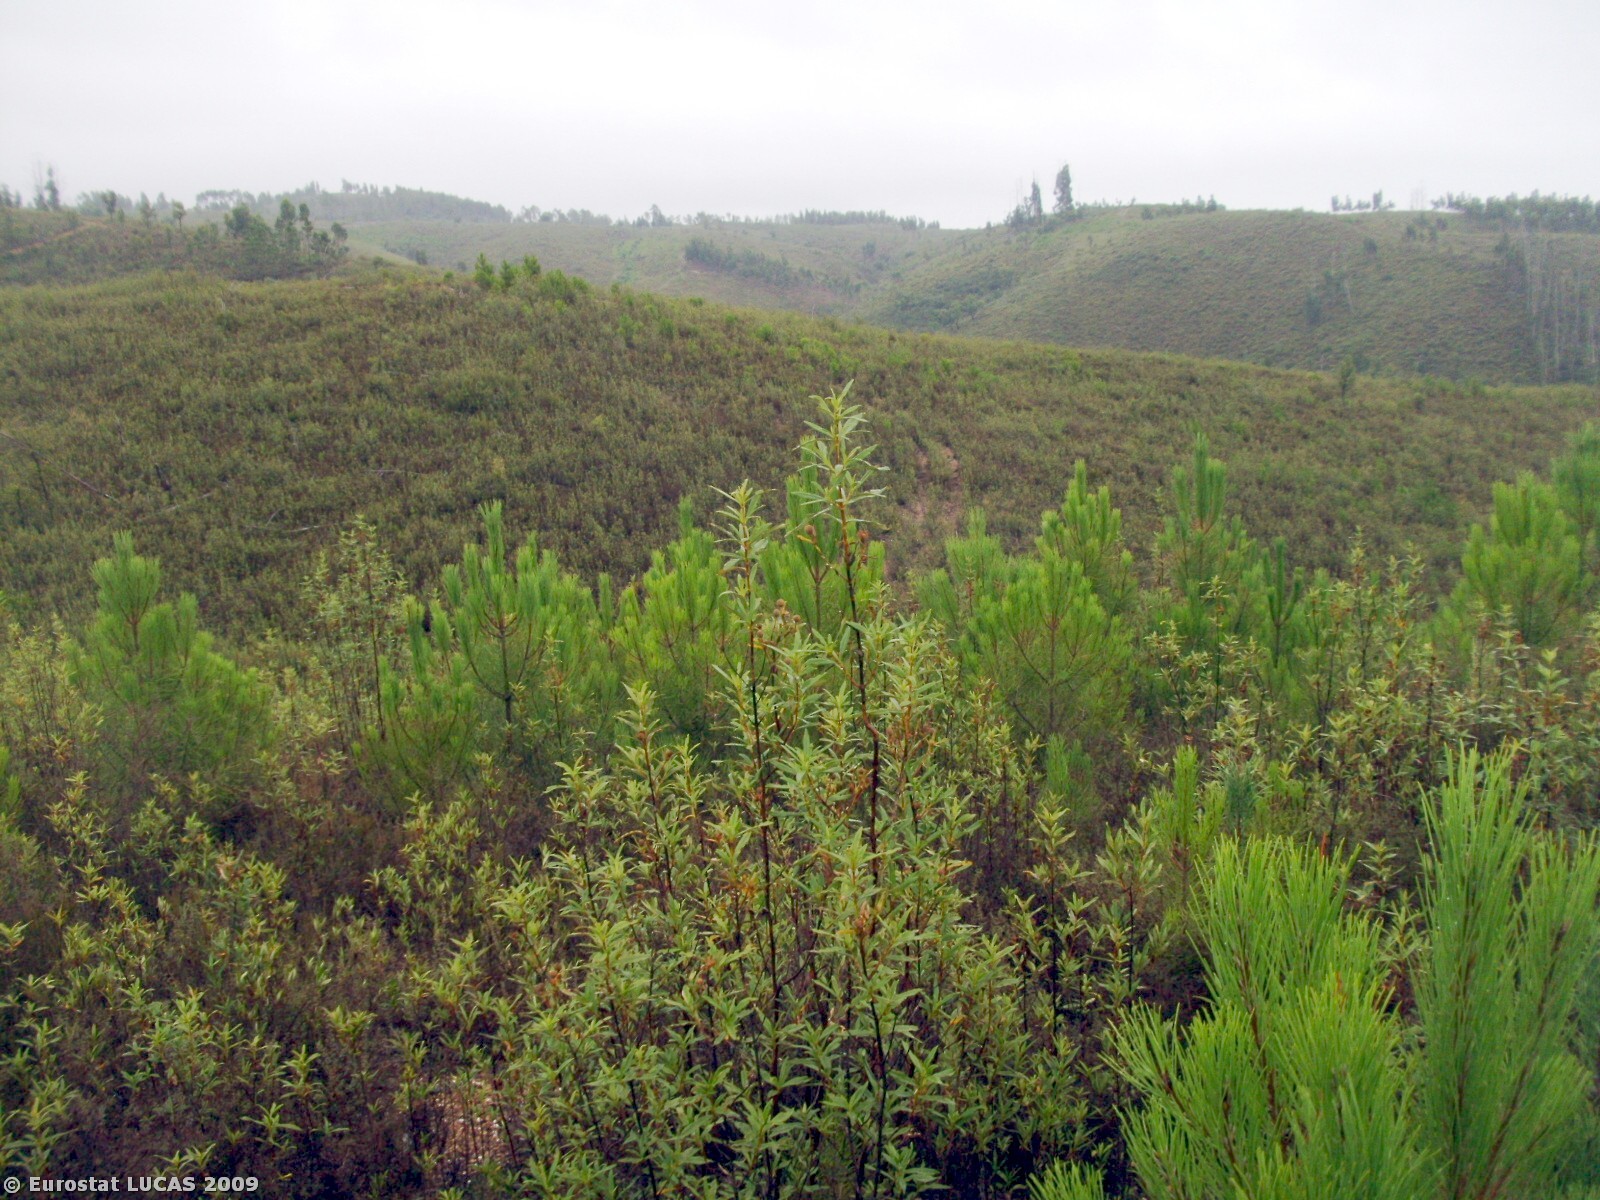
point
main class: Shrubland
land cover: Shrubland with sparse tree cover
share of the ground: > 75 %
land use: Unused
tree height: > 5 m
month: July
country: PT
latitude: 39.7162
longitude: -8.0881
